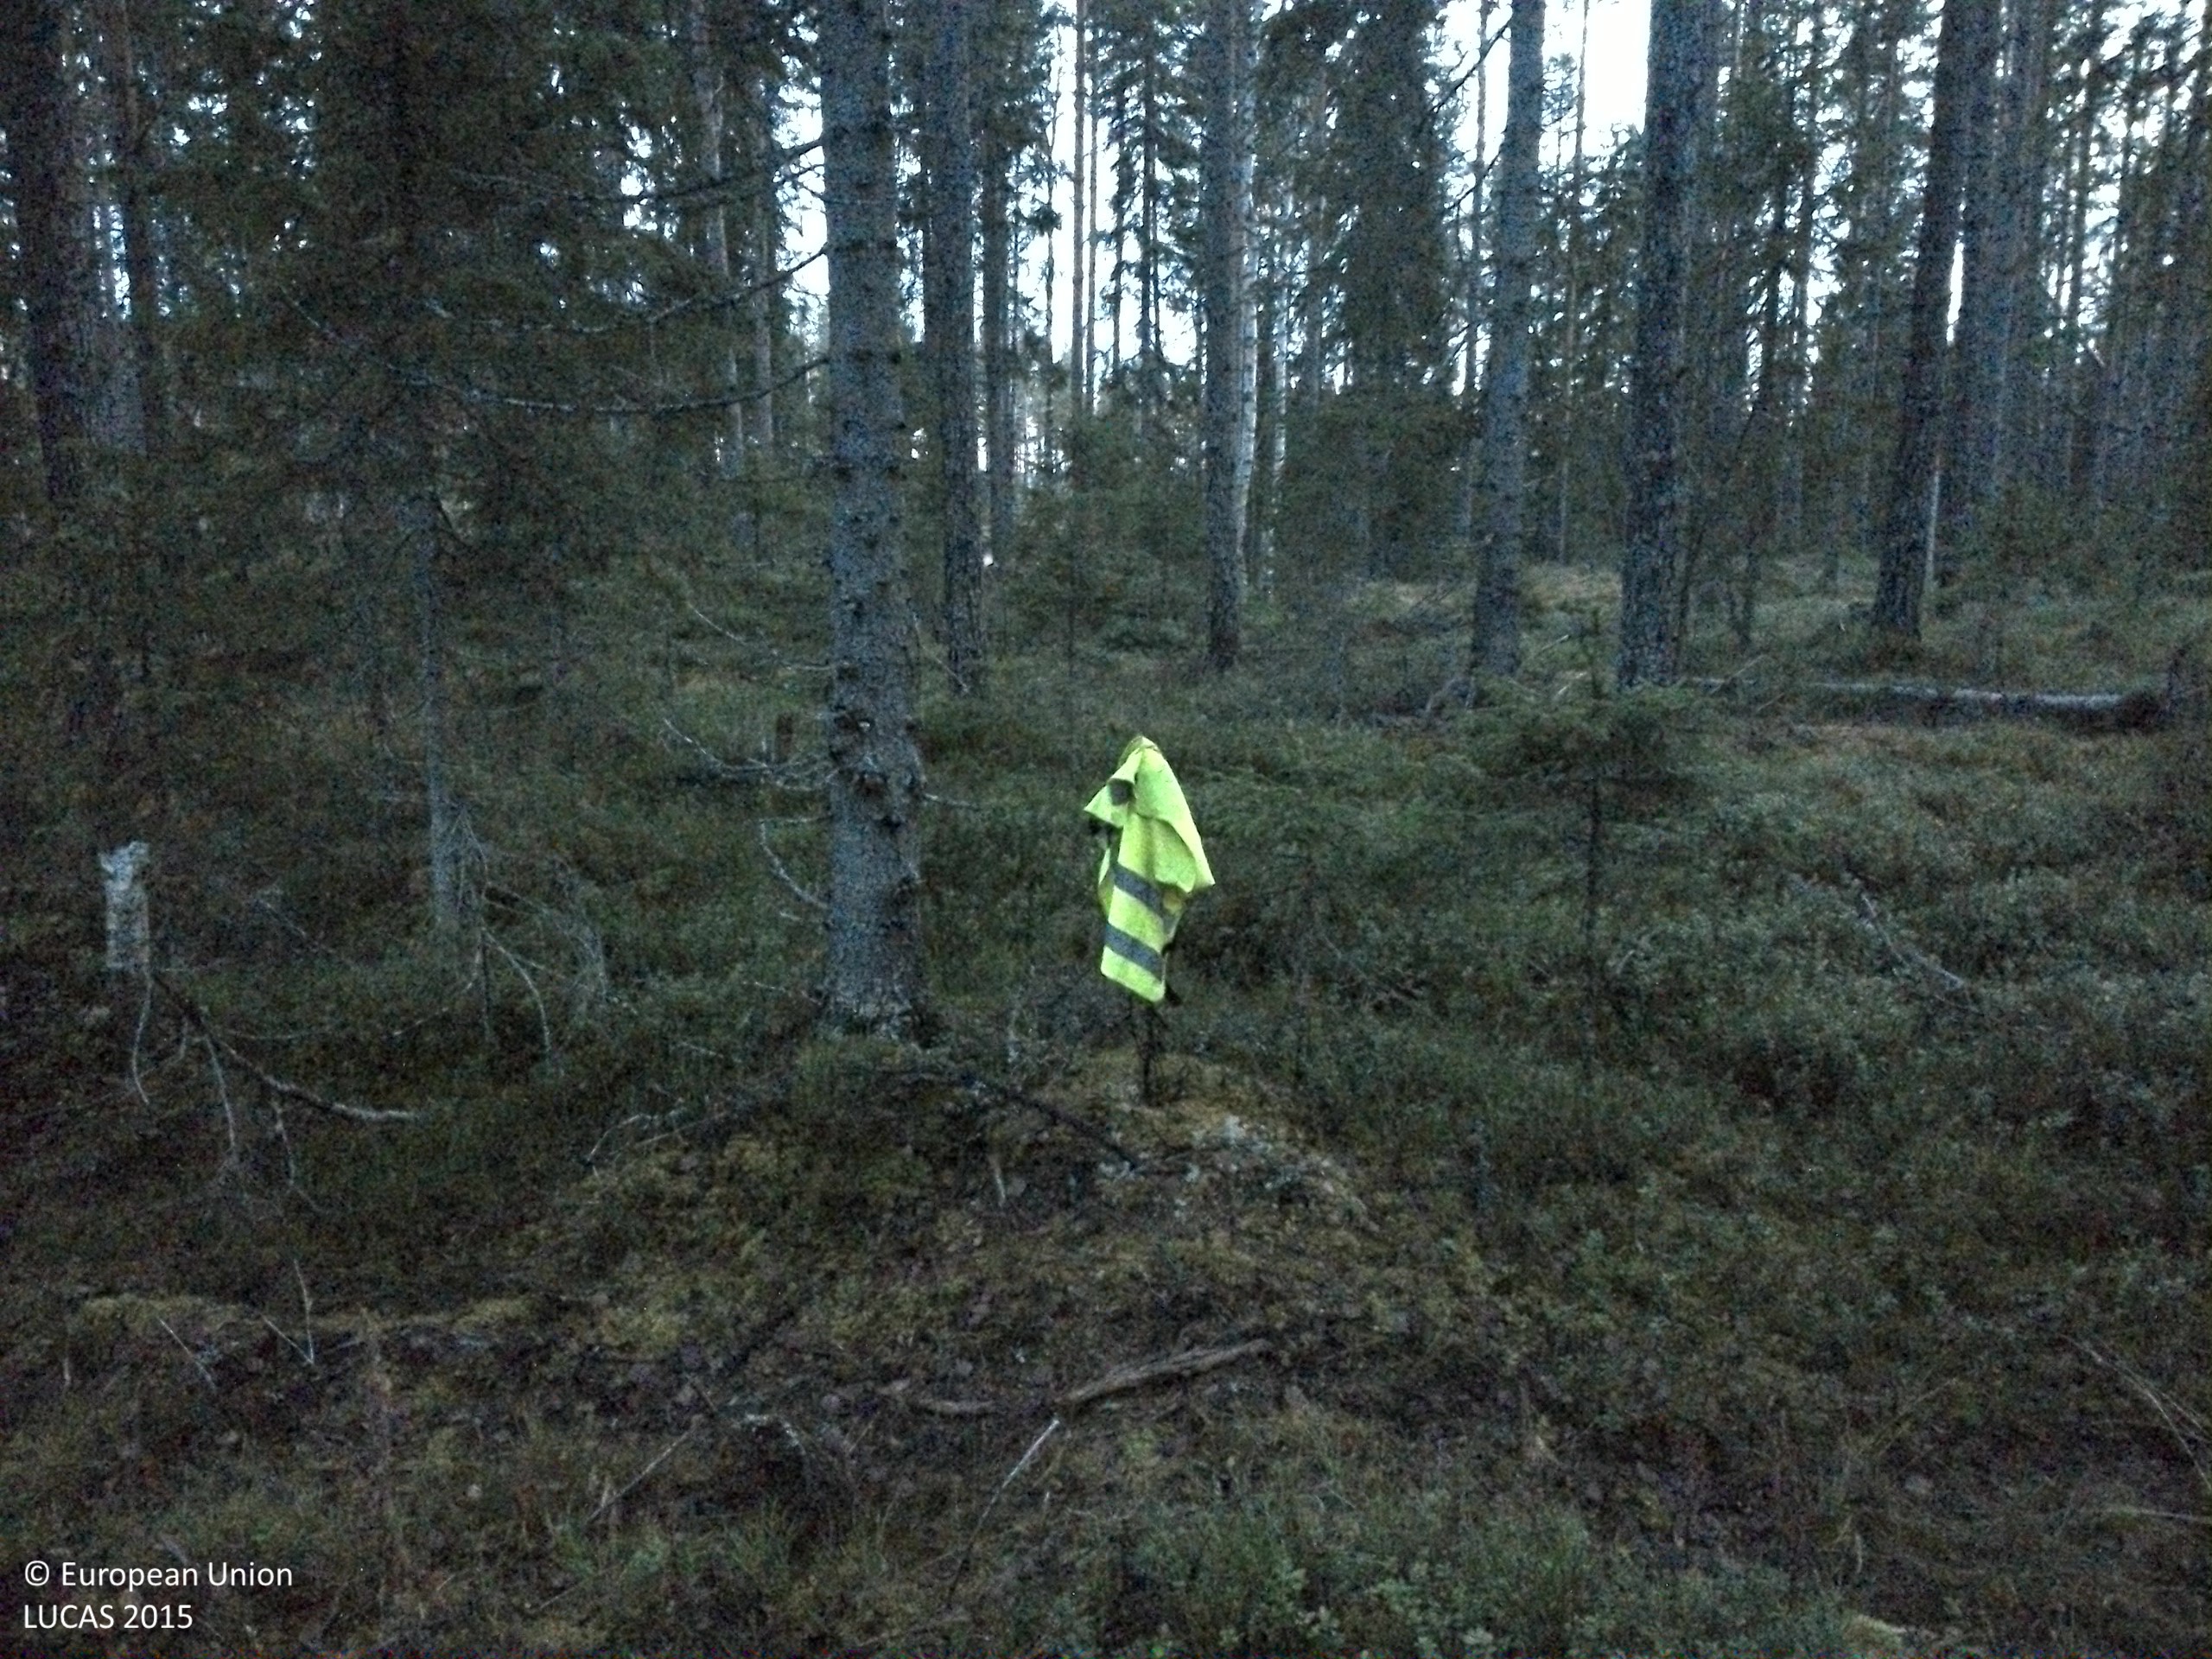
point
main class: Woodland
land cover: Other coniferous woodland
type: boreal forest
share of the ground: 50 - 75 %
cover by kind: coniferous forest trees 50 %, shrubs 30 %, lichens and mosses 15 %, broadleaved forest trees 5 %
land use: Forestry
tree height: > 5 m
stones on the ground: 10 - 25 %
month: October
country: SE
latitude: 63.7789
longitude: 15.4713
